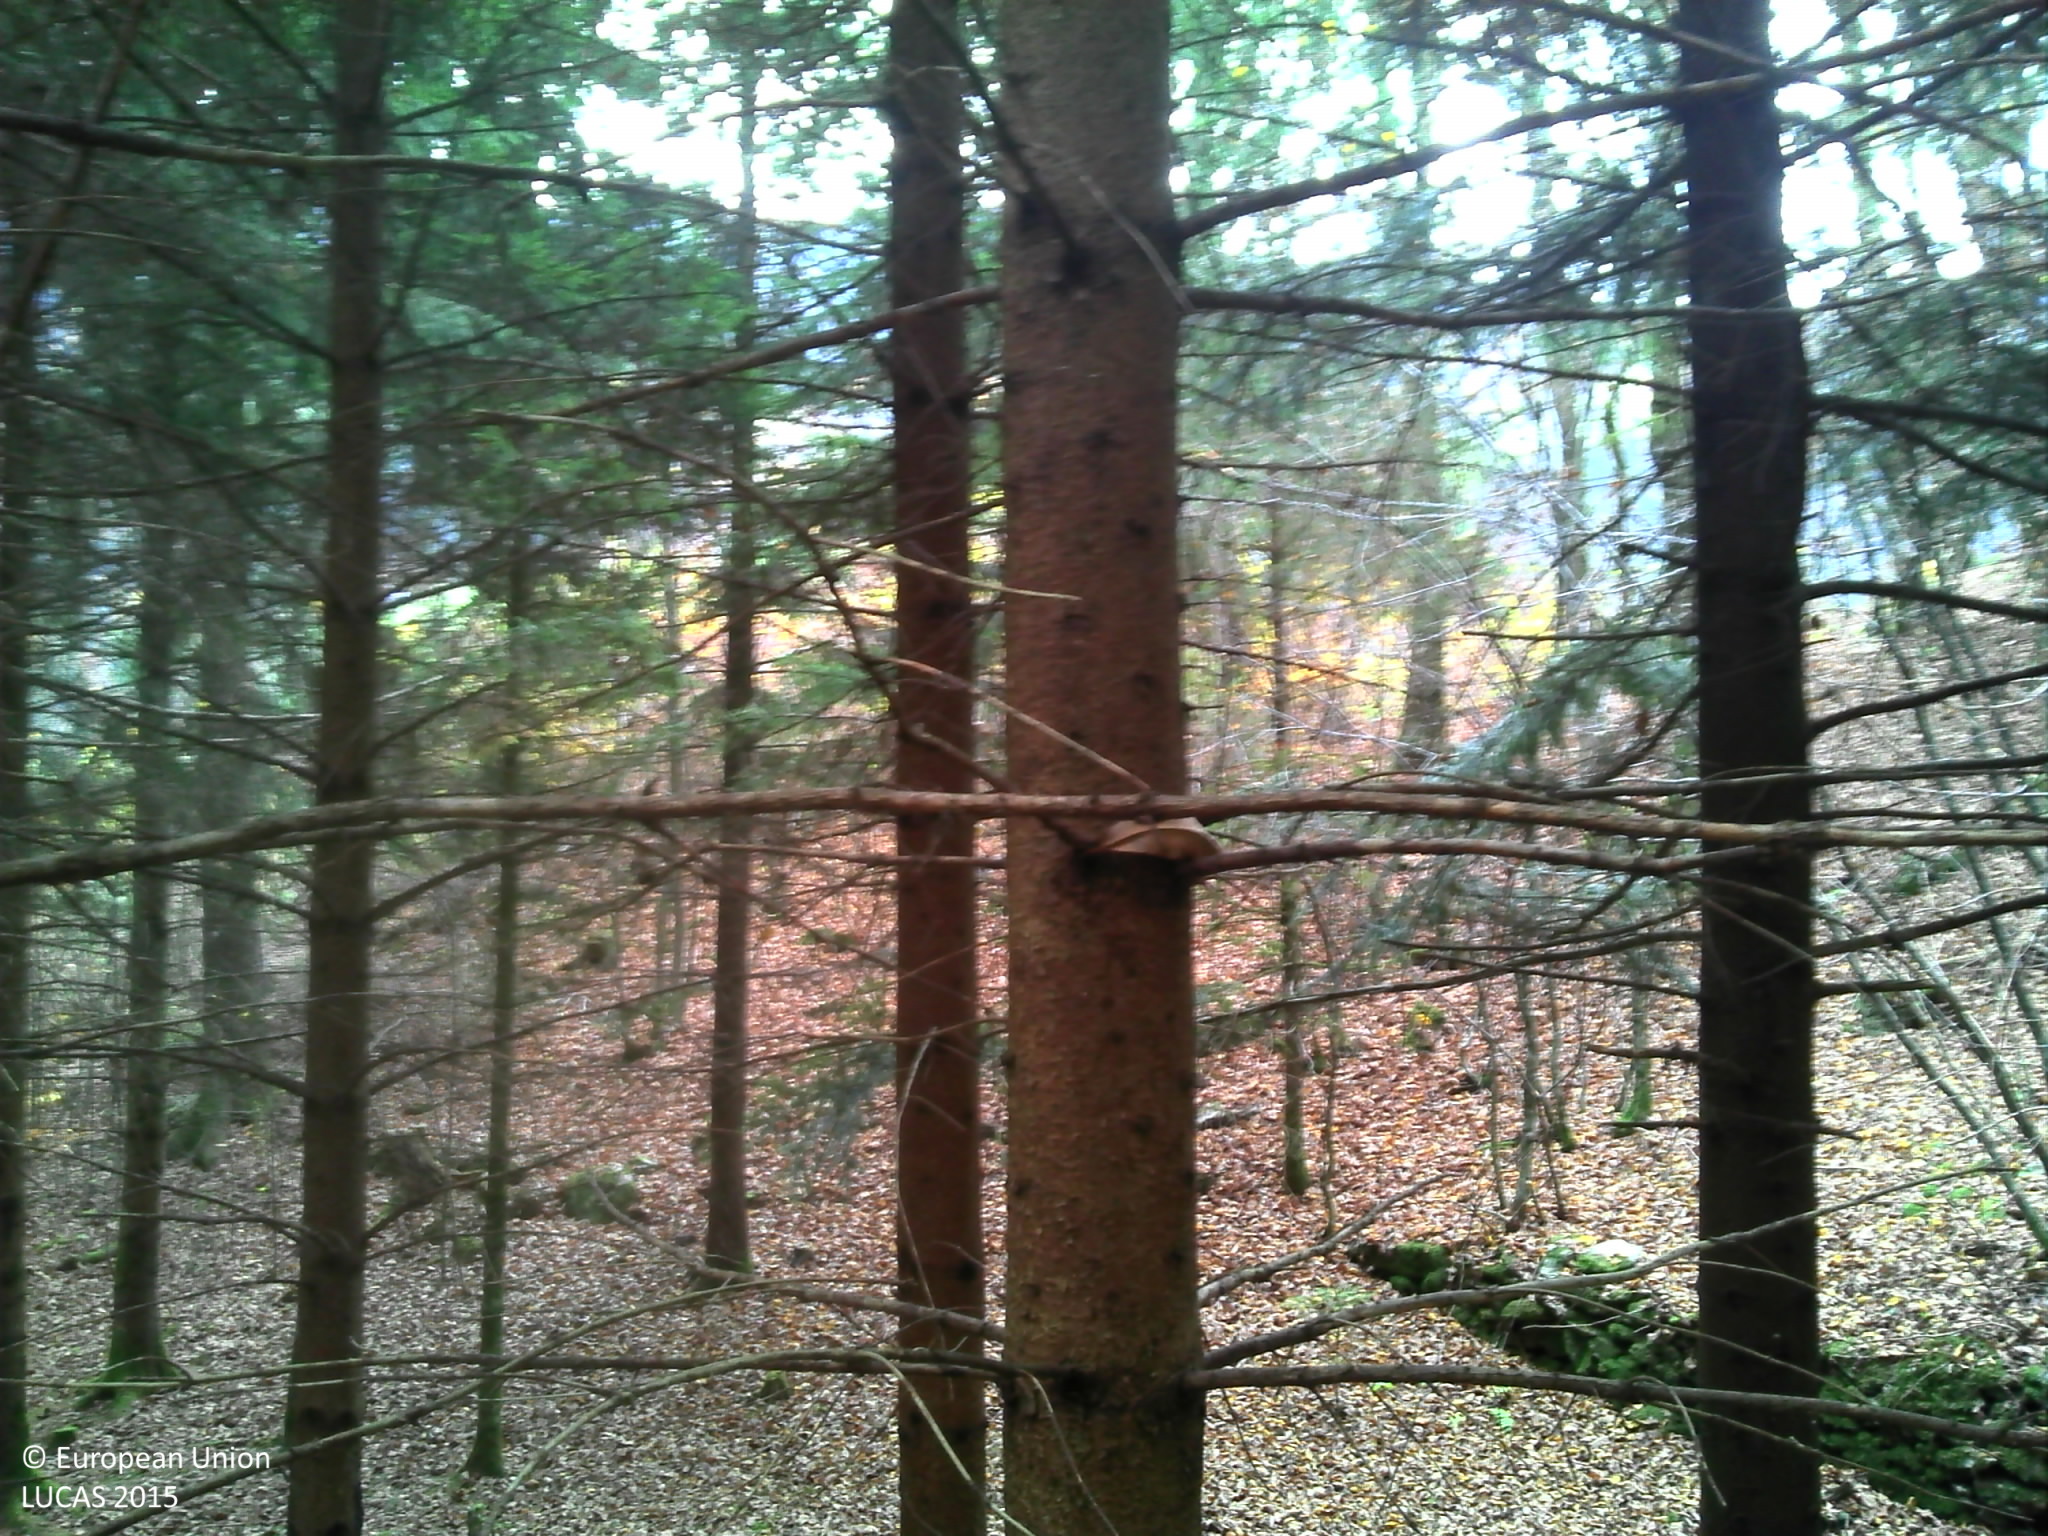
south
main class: Woodland
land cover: Spruce dominated mixed woodland
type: hemiboreal forest and nemoral coniferous forest and mixed broadleaved-coniferous forest
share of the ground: > 75 %
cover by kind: coniferous forest trees 50 %, broadleaved forest trees 40 %, consolidated bare surface 10 %
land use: Forestry
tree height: > 5 m
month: November
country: FR
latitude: 45.7160
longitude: 6.4713
